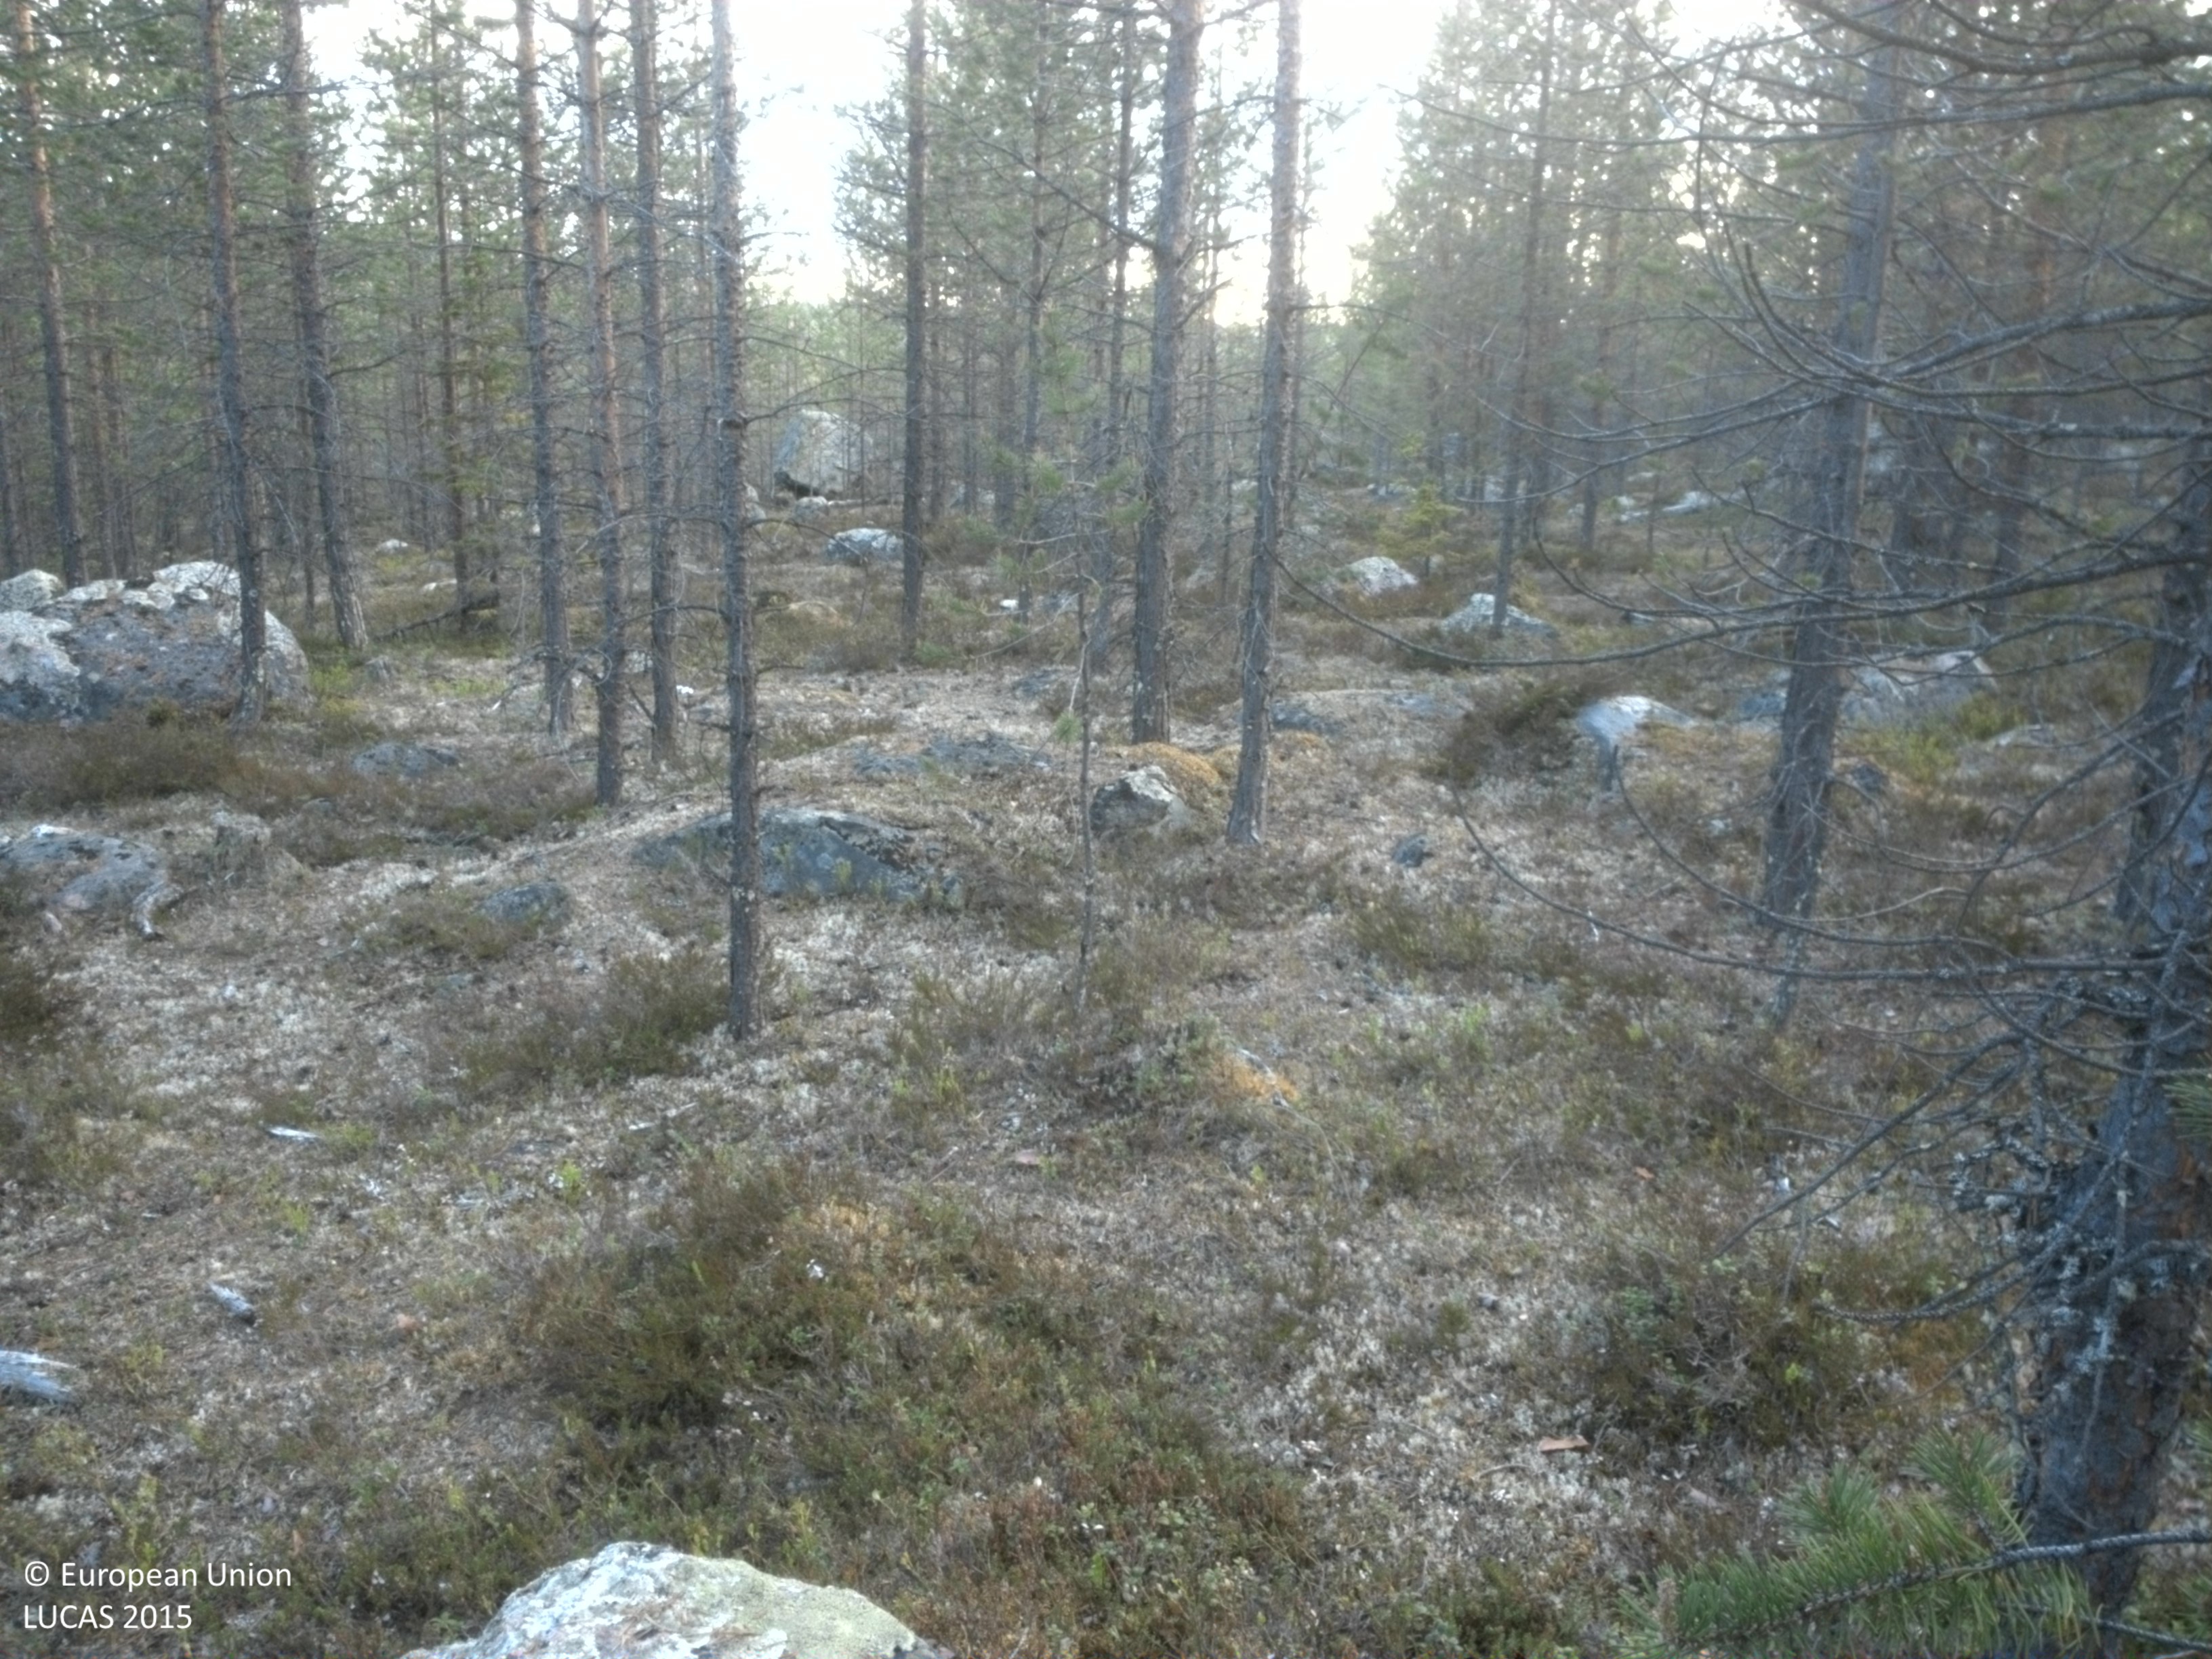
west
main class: Woodland
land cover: Pine dominated coniferous woodland
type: boreal forest
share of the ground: 25 - 50 %
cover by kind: shrubs 40 %, lichens and mosses 30 %, coniferous forest trees 25 %, unconsolidated bare surface 5 %
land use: Forestry
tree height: > 5 m
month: June
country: SE
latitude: 66.9029
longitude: 21.8618
